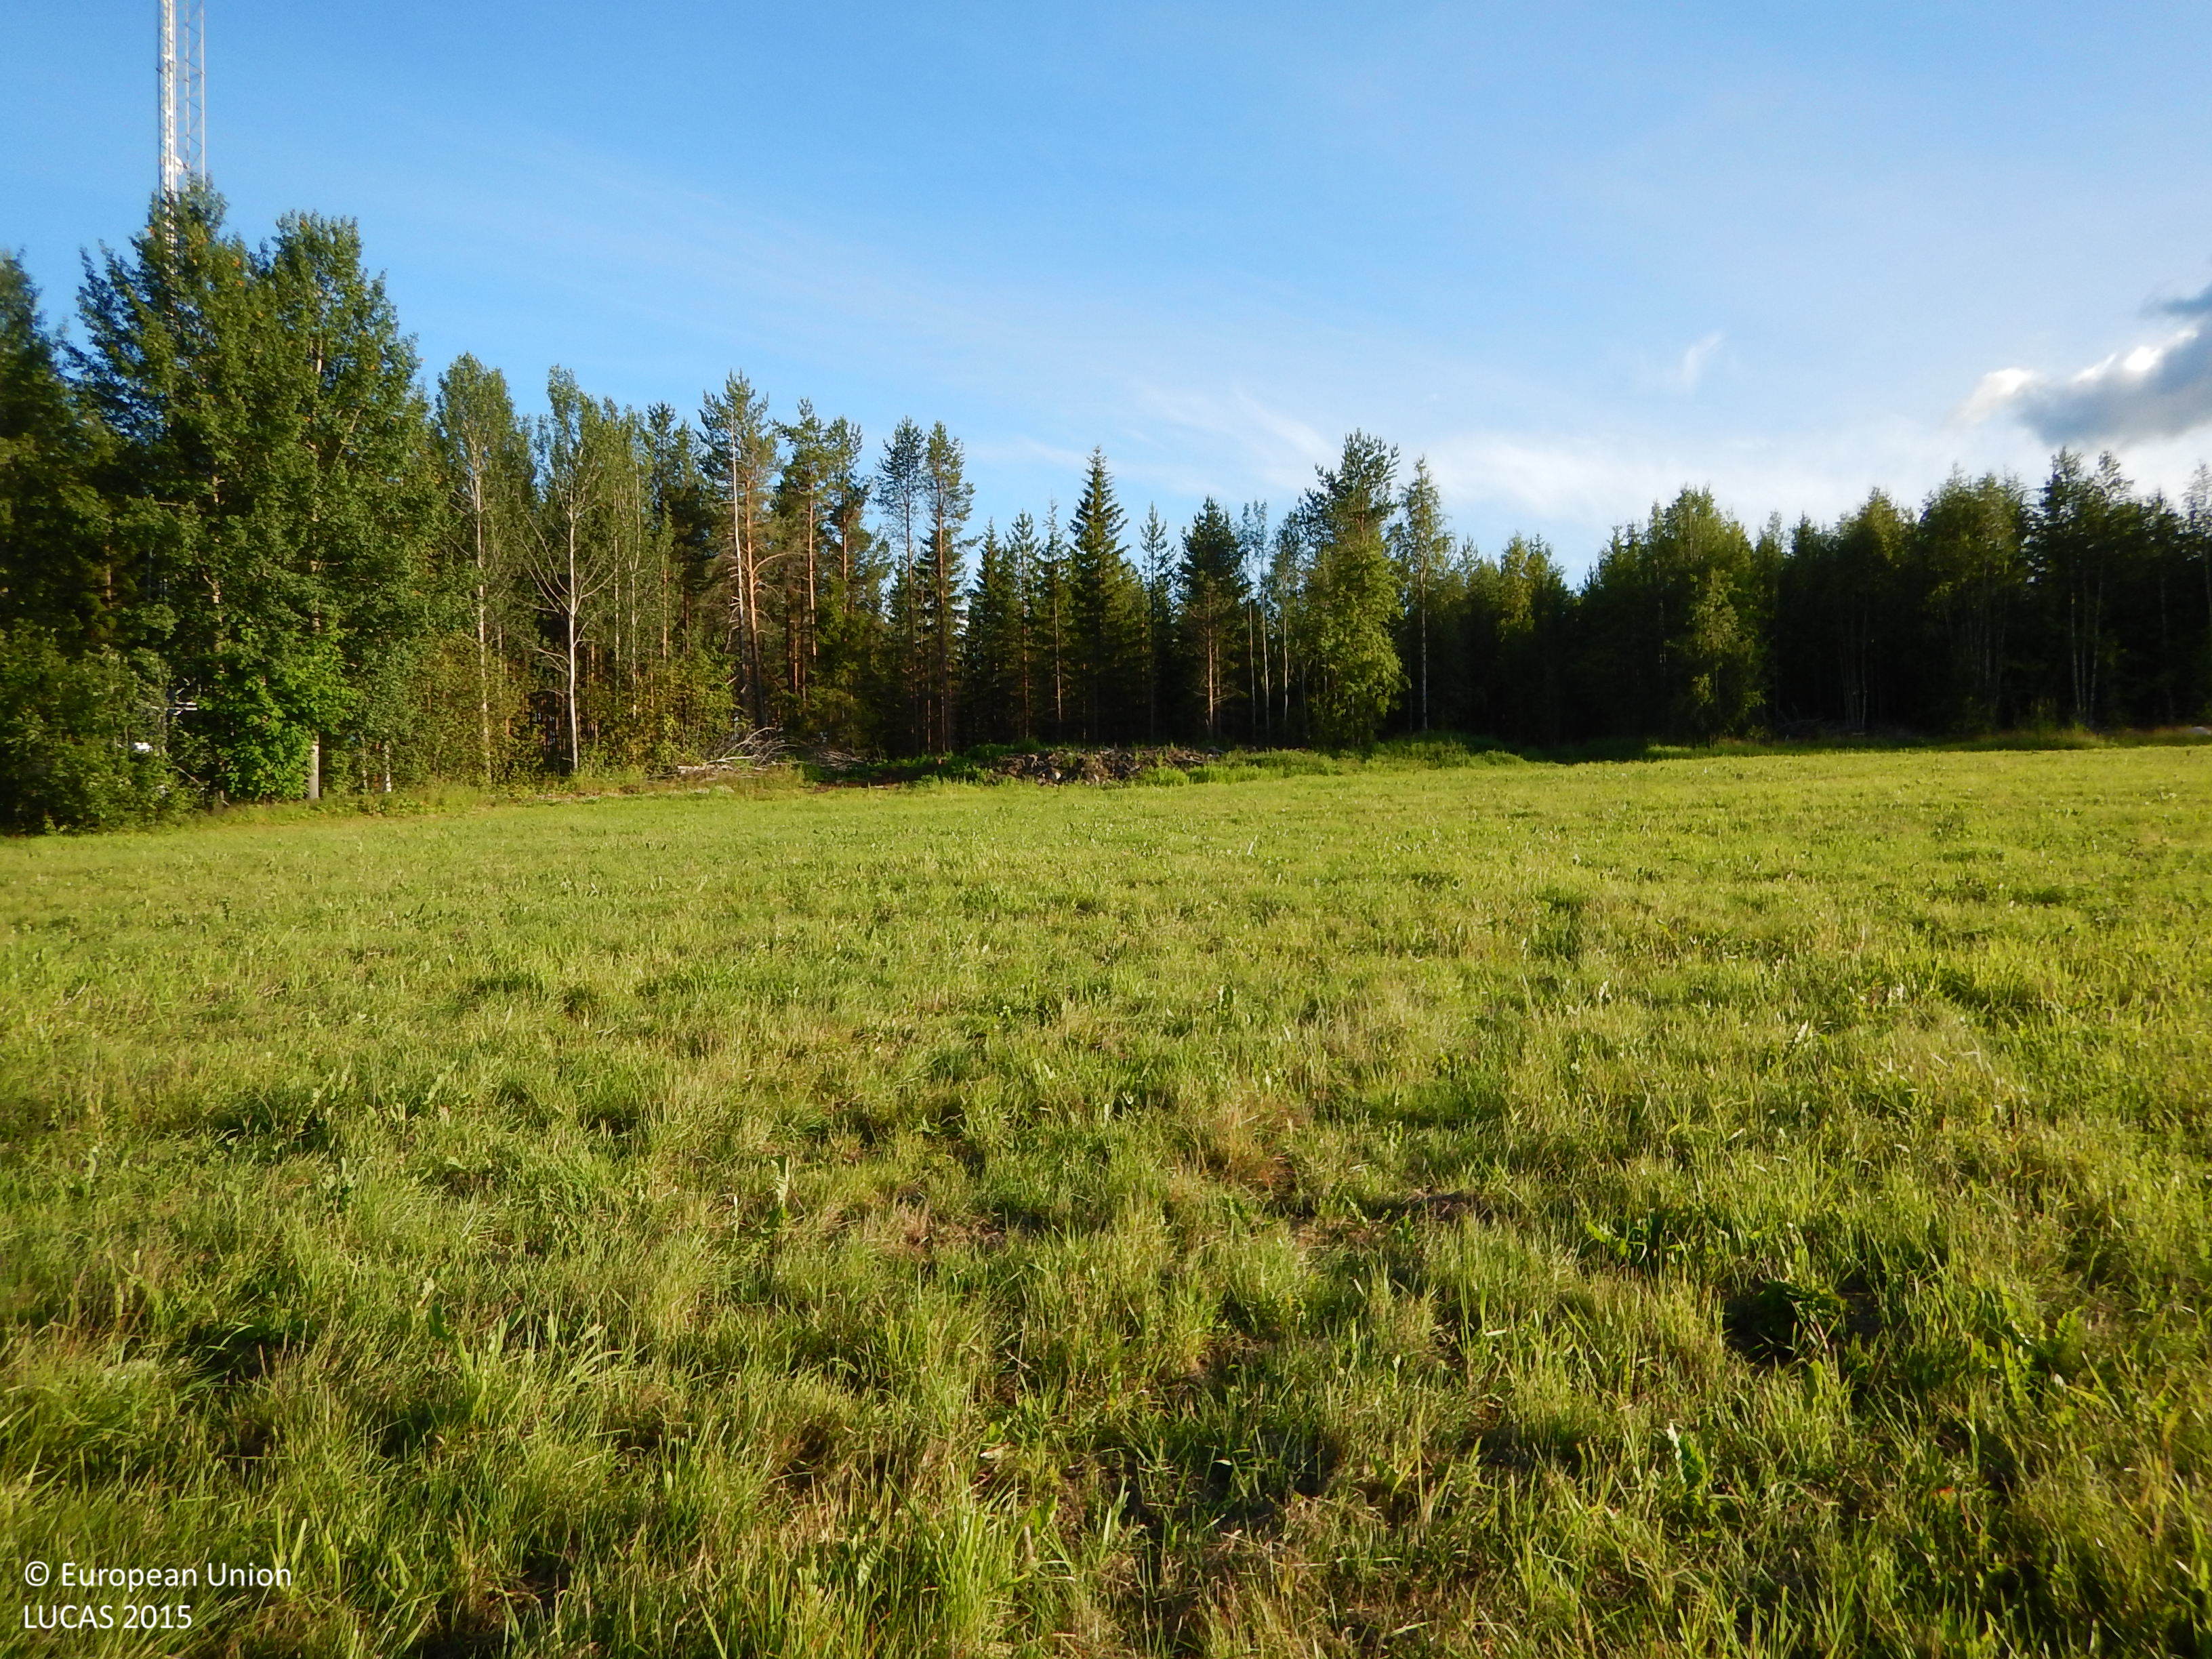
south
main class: Grassland
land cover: Grassland without tree/shrub cover
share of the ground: > 75 %
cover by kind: herbaceous plants 100 %
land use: Agriculture (excluding fallow land and kitchen gardens)
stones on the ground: < 10 %
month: July
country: SE
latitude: 64.7715
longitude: 20.8904
